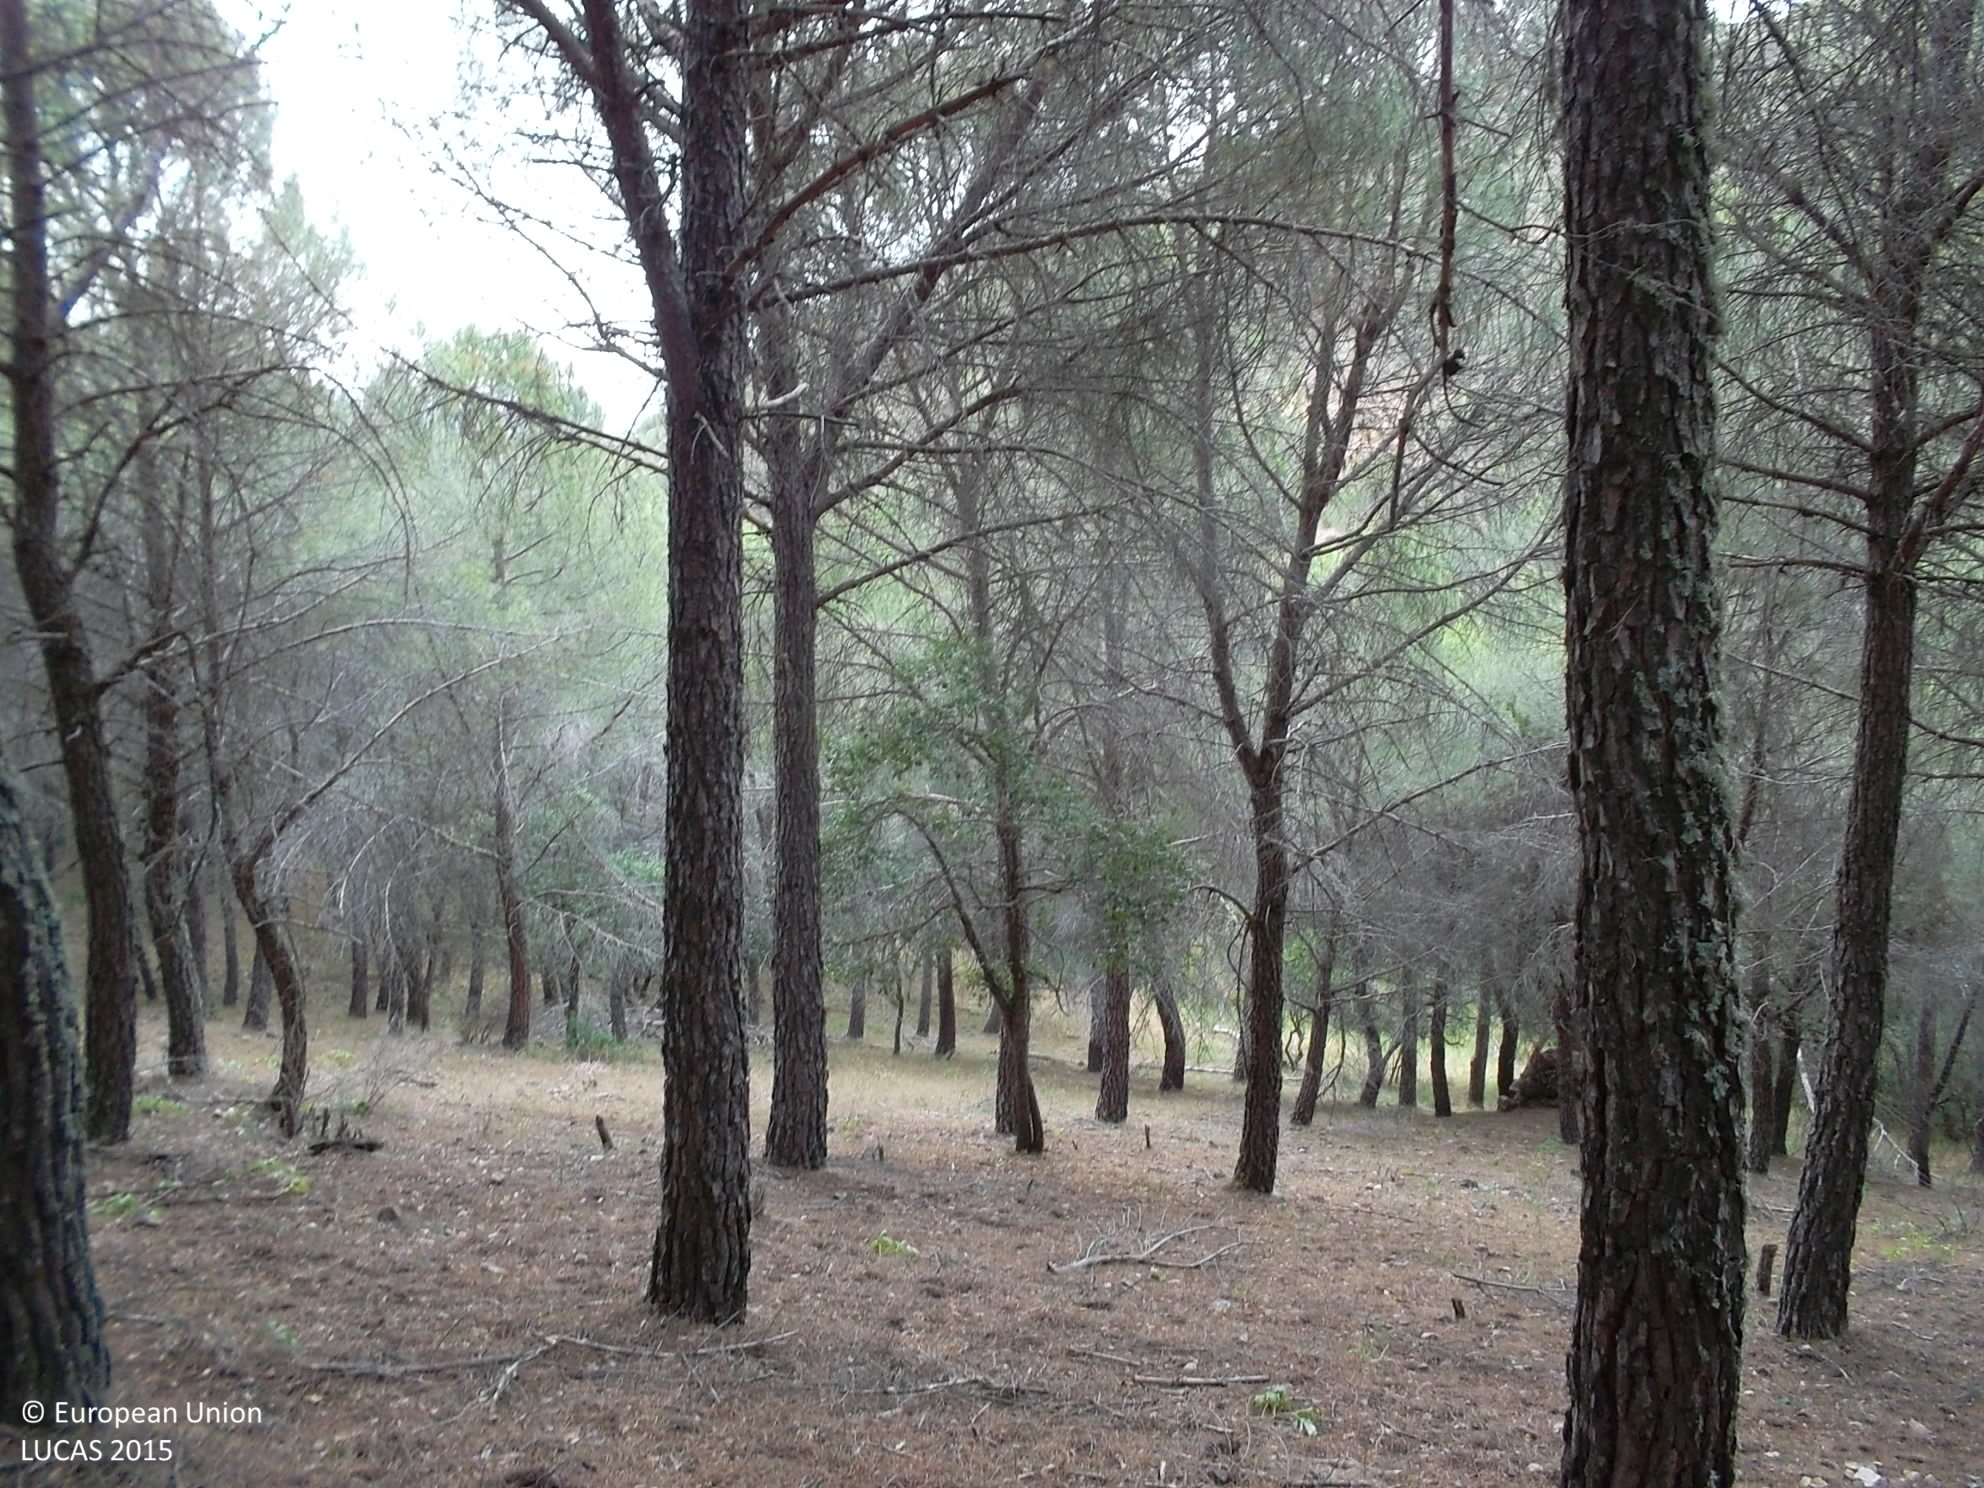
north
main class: Woodland
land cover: Pine dominated coniferous woodland
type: alpine coniferous forest
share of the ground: > 75 %
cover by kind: coniferous forest trees 100 %
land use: Forestry
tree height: > 5 m
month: June
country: ES
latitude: 39.0008
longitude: -4.4964
